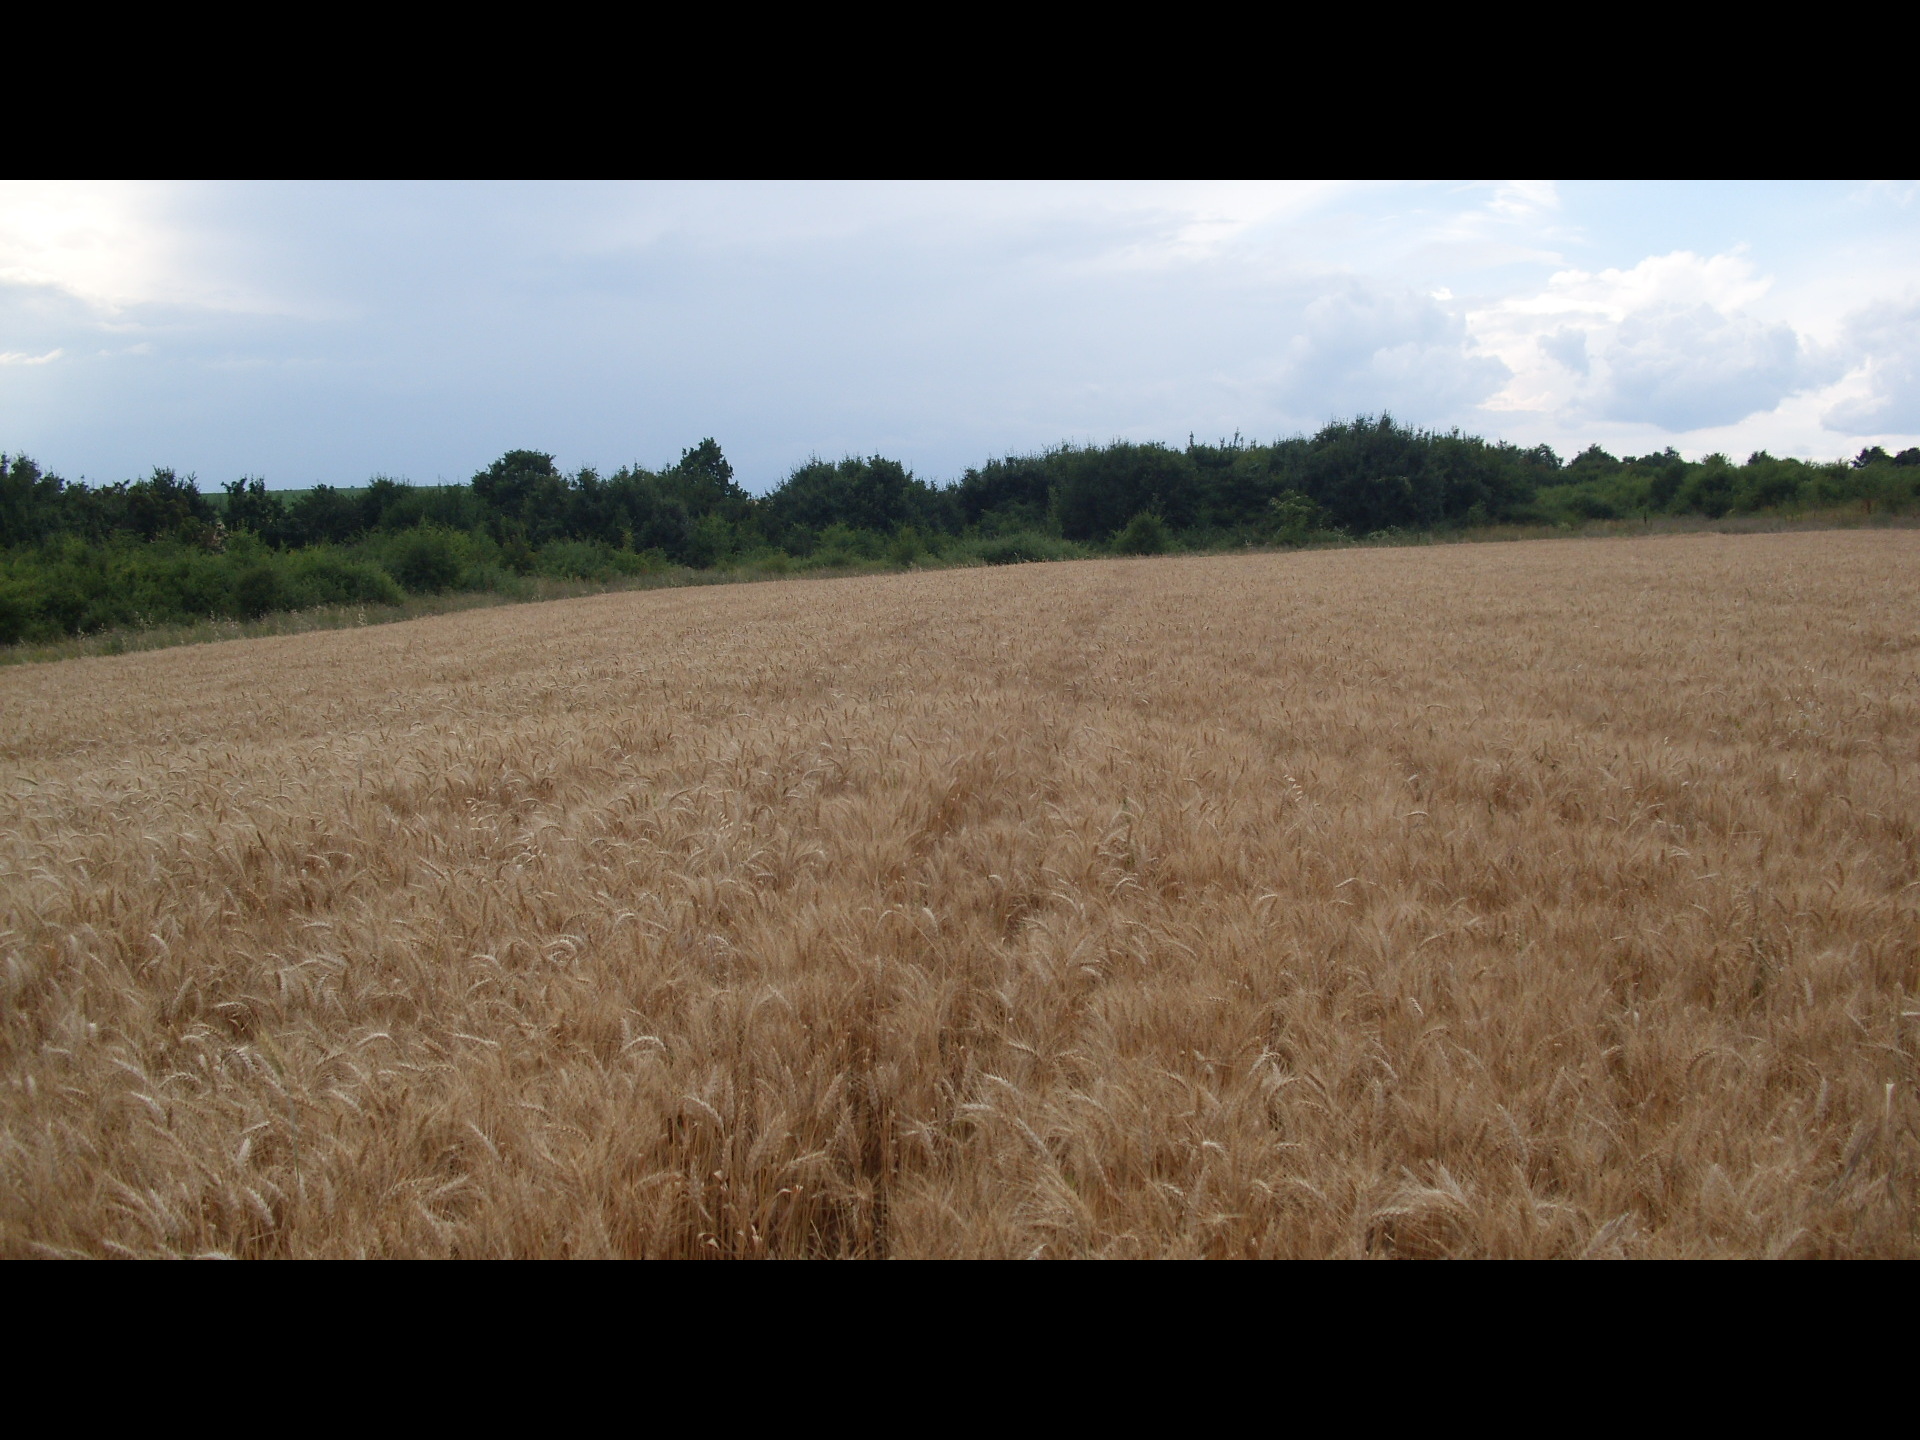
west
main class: Cropland
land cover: Common wheat
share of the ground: > 75 %
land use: Agriculture (excluding fallow land and kitchen gardens)
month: June
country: BG
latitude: 43.4631
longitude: 23.5044
